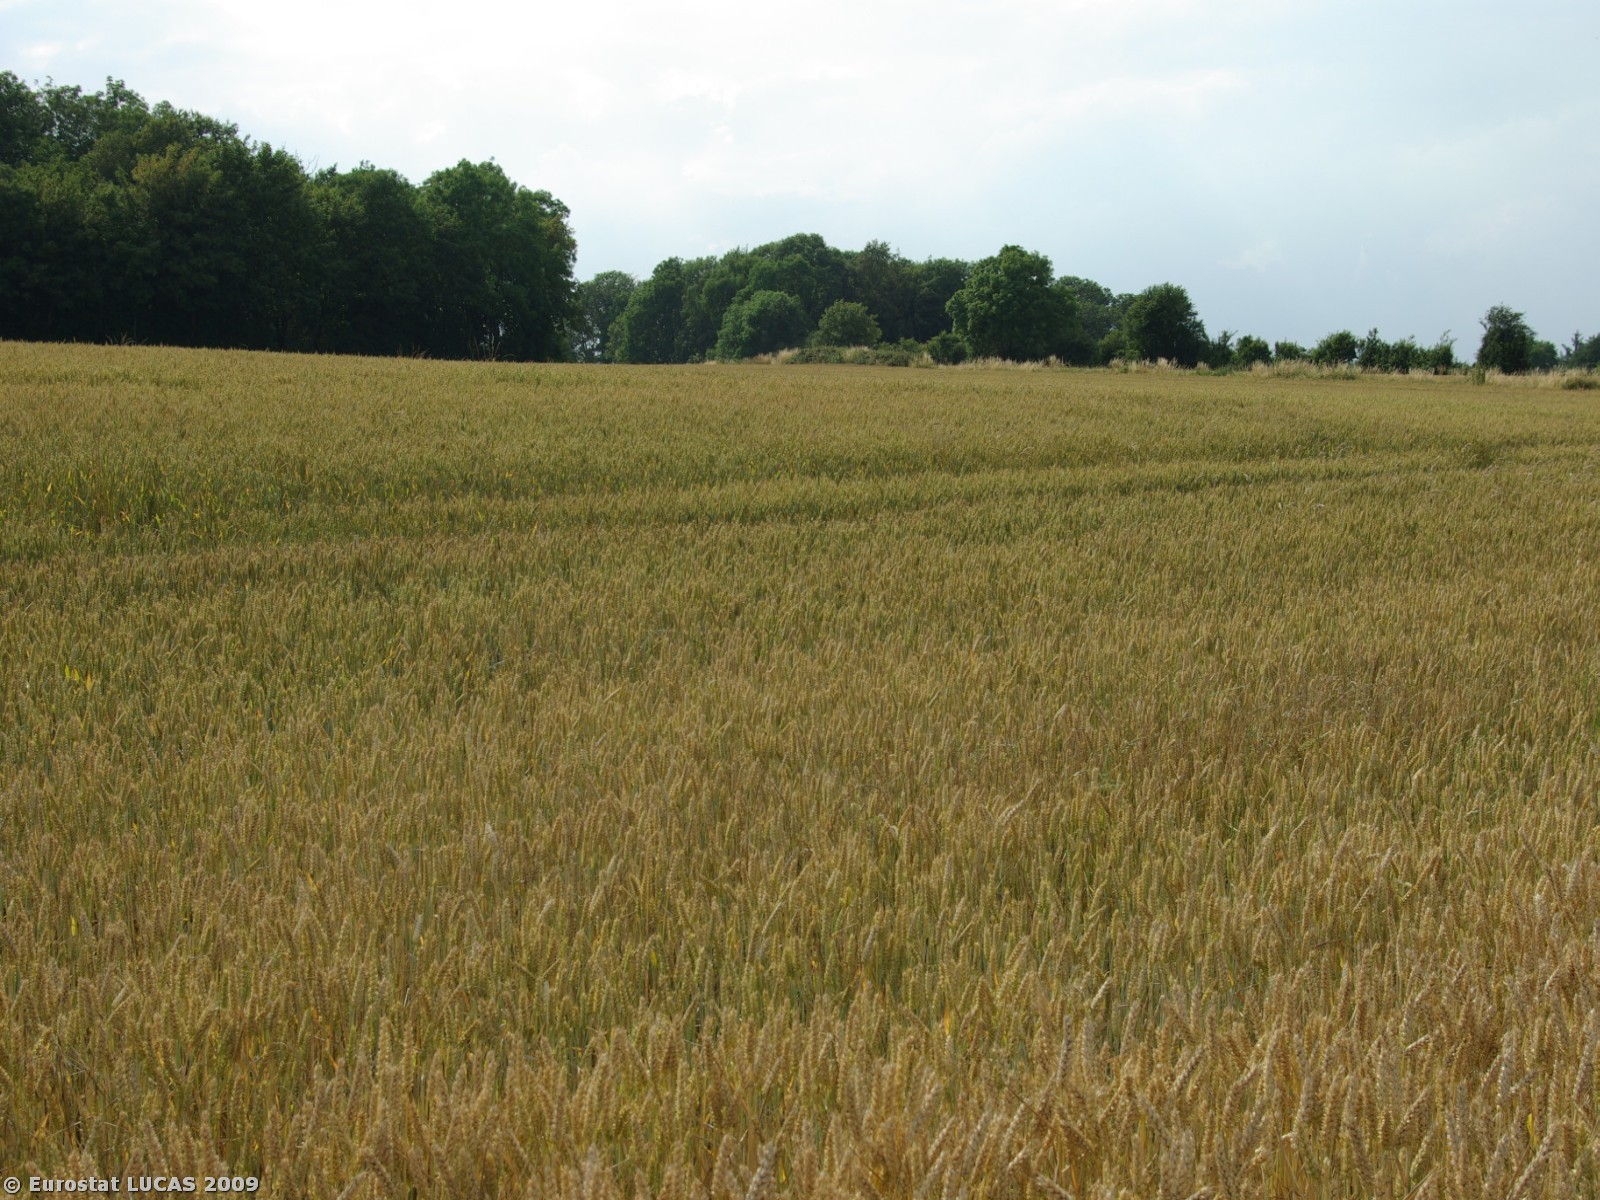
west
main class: Cropland
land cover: Common wheat
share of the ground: > 75 %
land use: Agriculture (excluding fallow land and kitchen gardens)
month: July
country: DK
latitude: 55.0373
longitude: 9.8593
